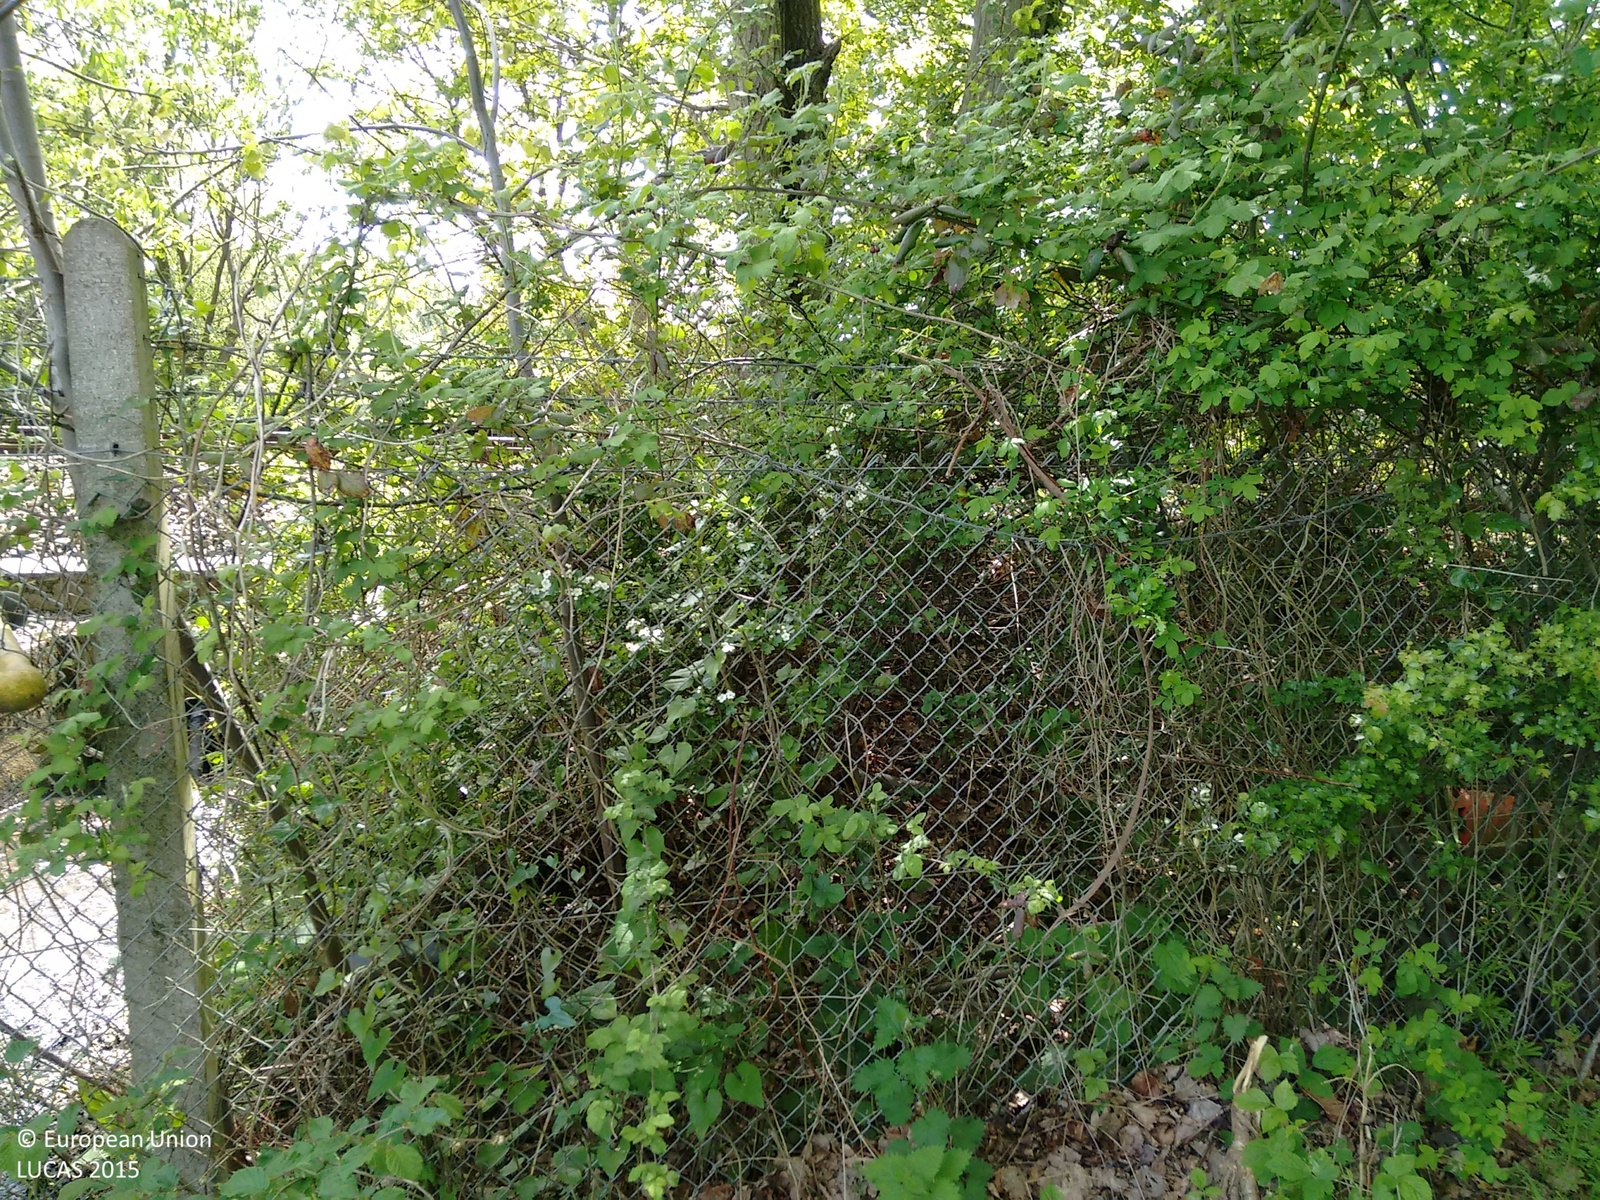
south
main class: Woodland
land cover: Broadleaved woodland
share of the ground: 25 - 50 %
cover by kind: broadleaved forest trees 45 %, herbaceous plants 45 %, shrubs 10 %
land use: Railway transport
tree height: > 5 m
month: May
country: GB
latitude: 51.1776
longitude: 0.4592
